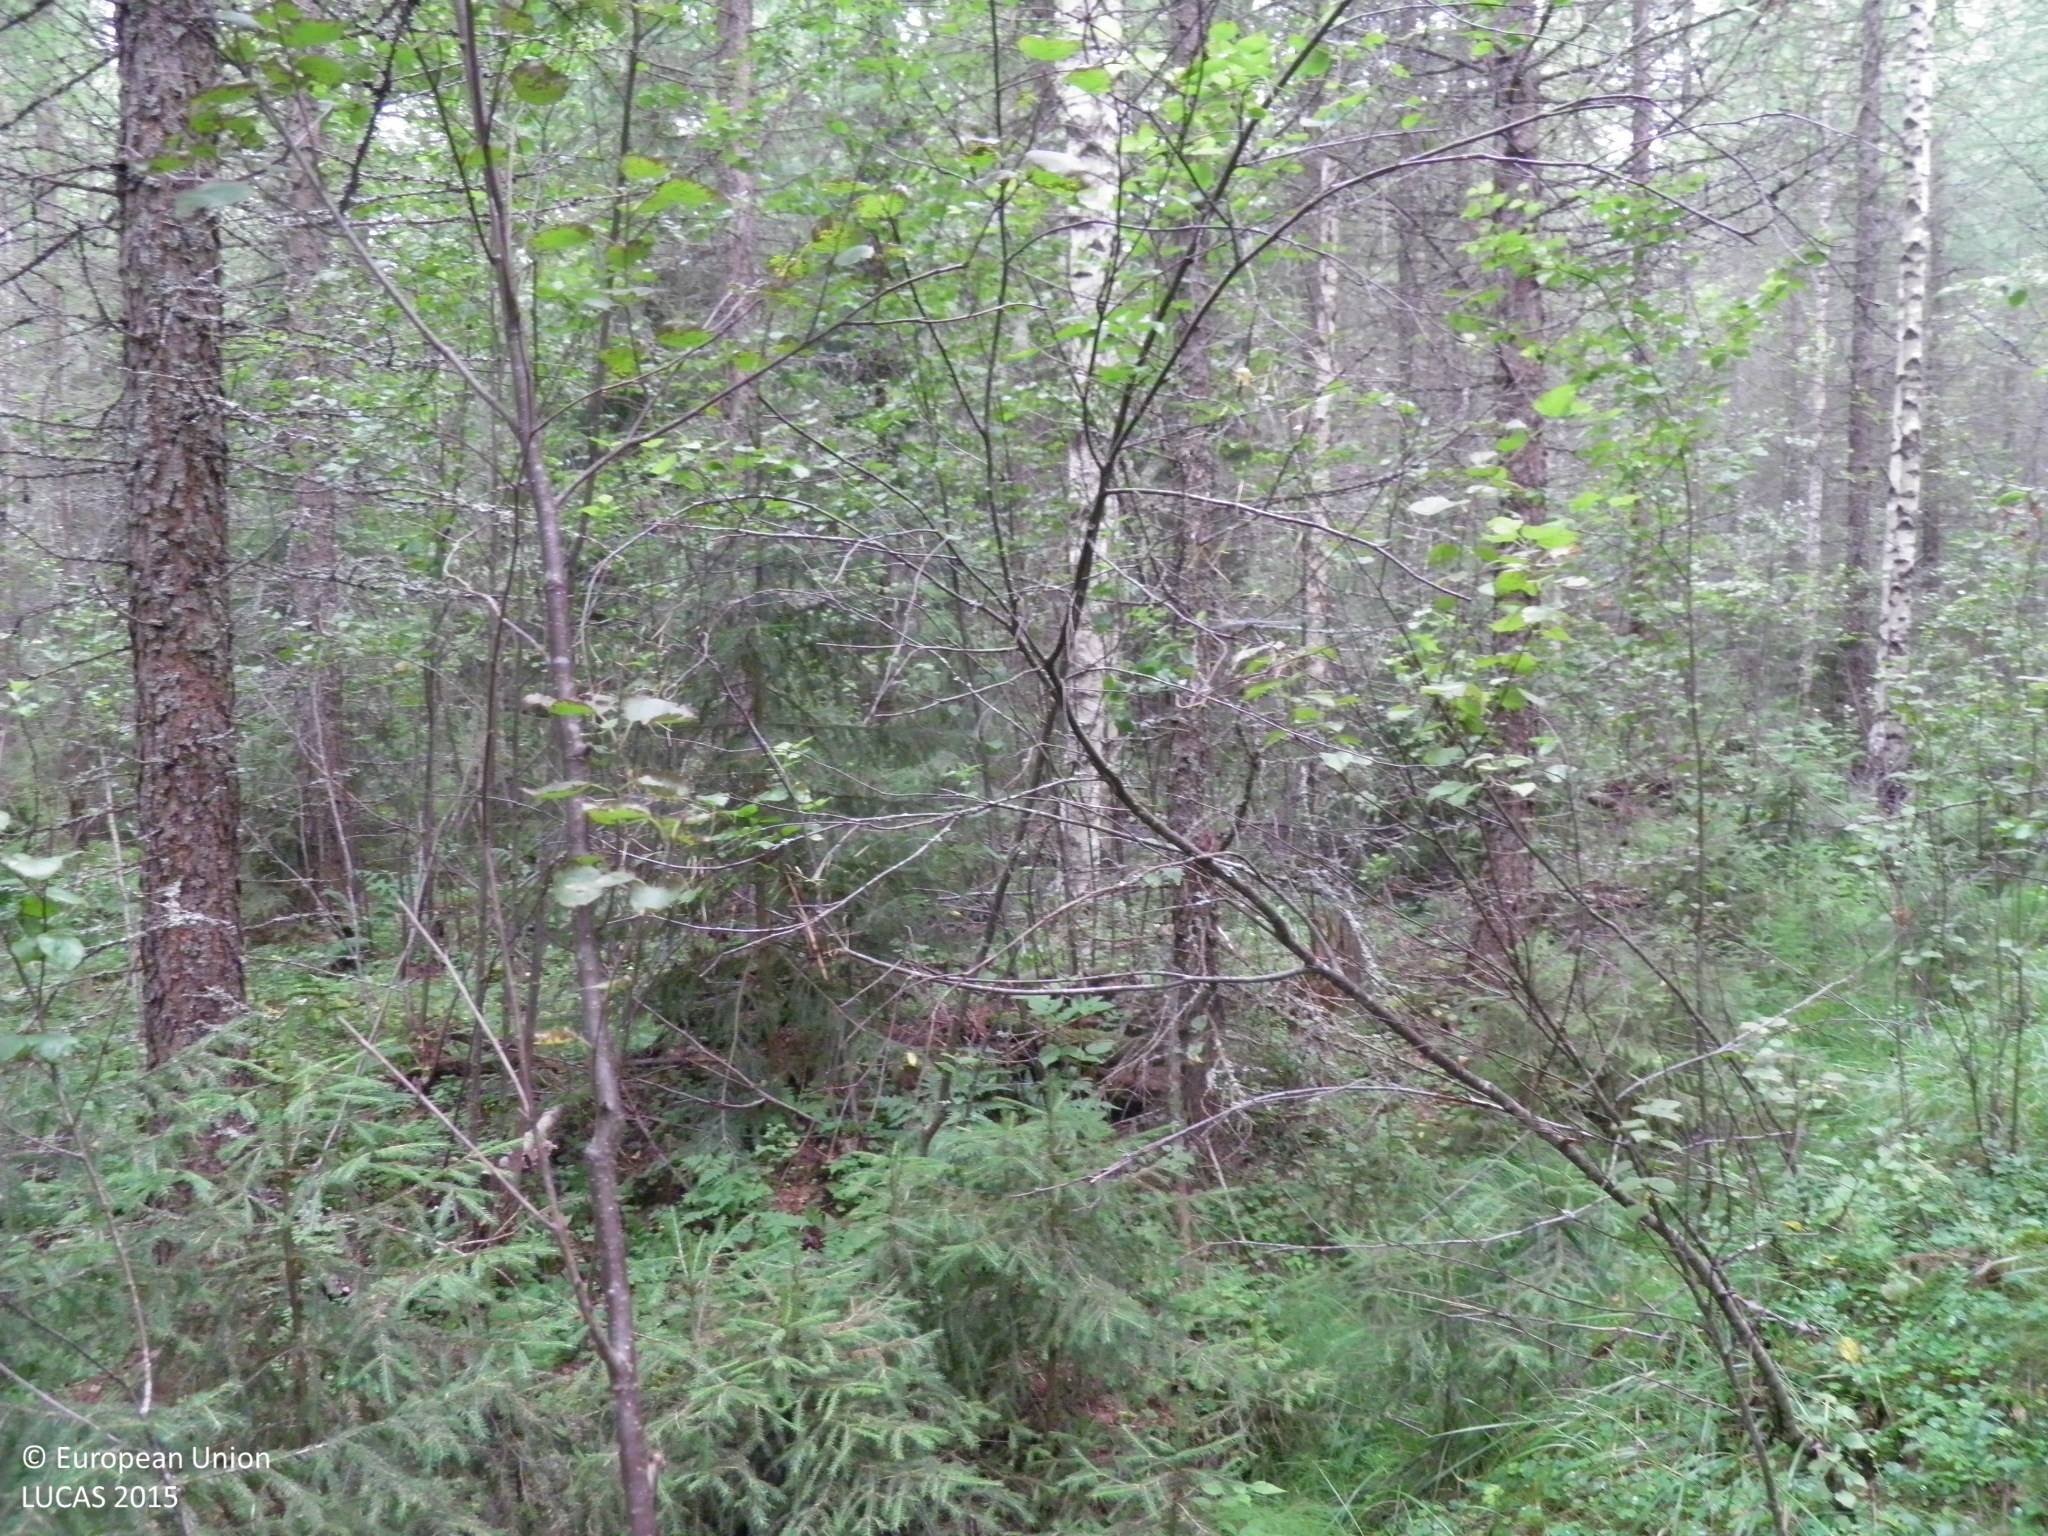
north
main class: Woodland
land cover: Pine dominated mixed woodland
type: hemiboreal forest and nemoral coniferous forest and mixed broadleaved-coniferous forest
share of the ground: > 75 %
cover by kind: broadleaved forest trees 45 %, coniferous forest trees 40 %, shrubs 5 %, herbaceous plants 5 %, lichens and mosses 5 %
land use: Forestry
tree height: > 5 m
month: July
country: FI
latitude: 60.8642
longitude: 22.9075
